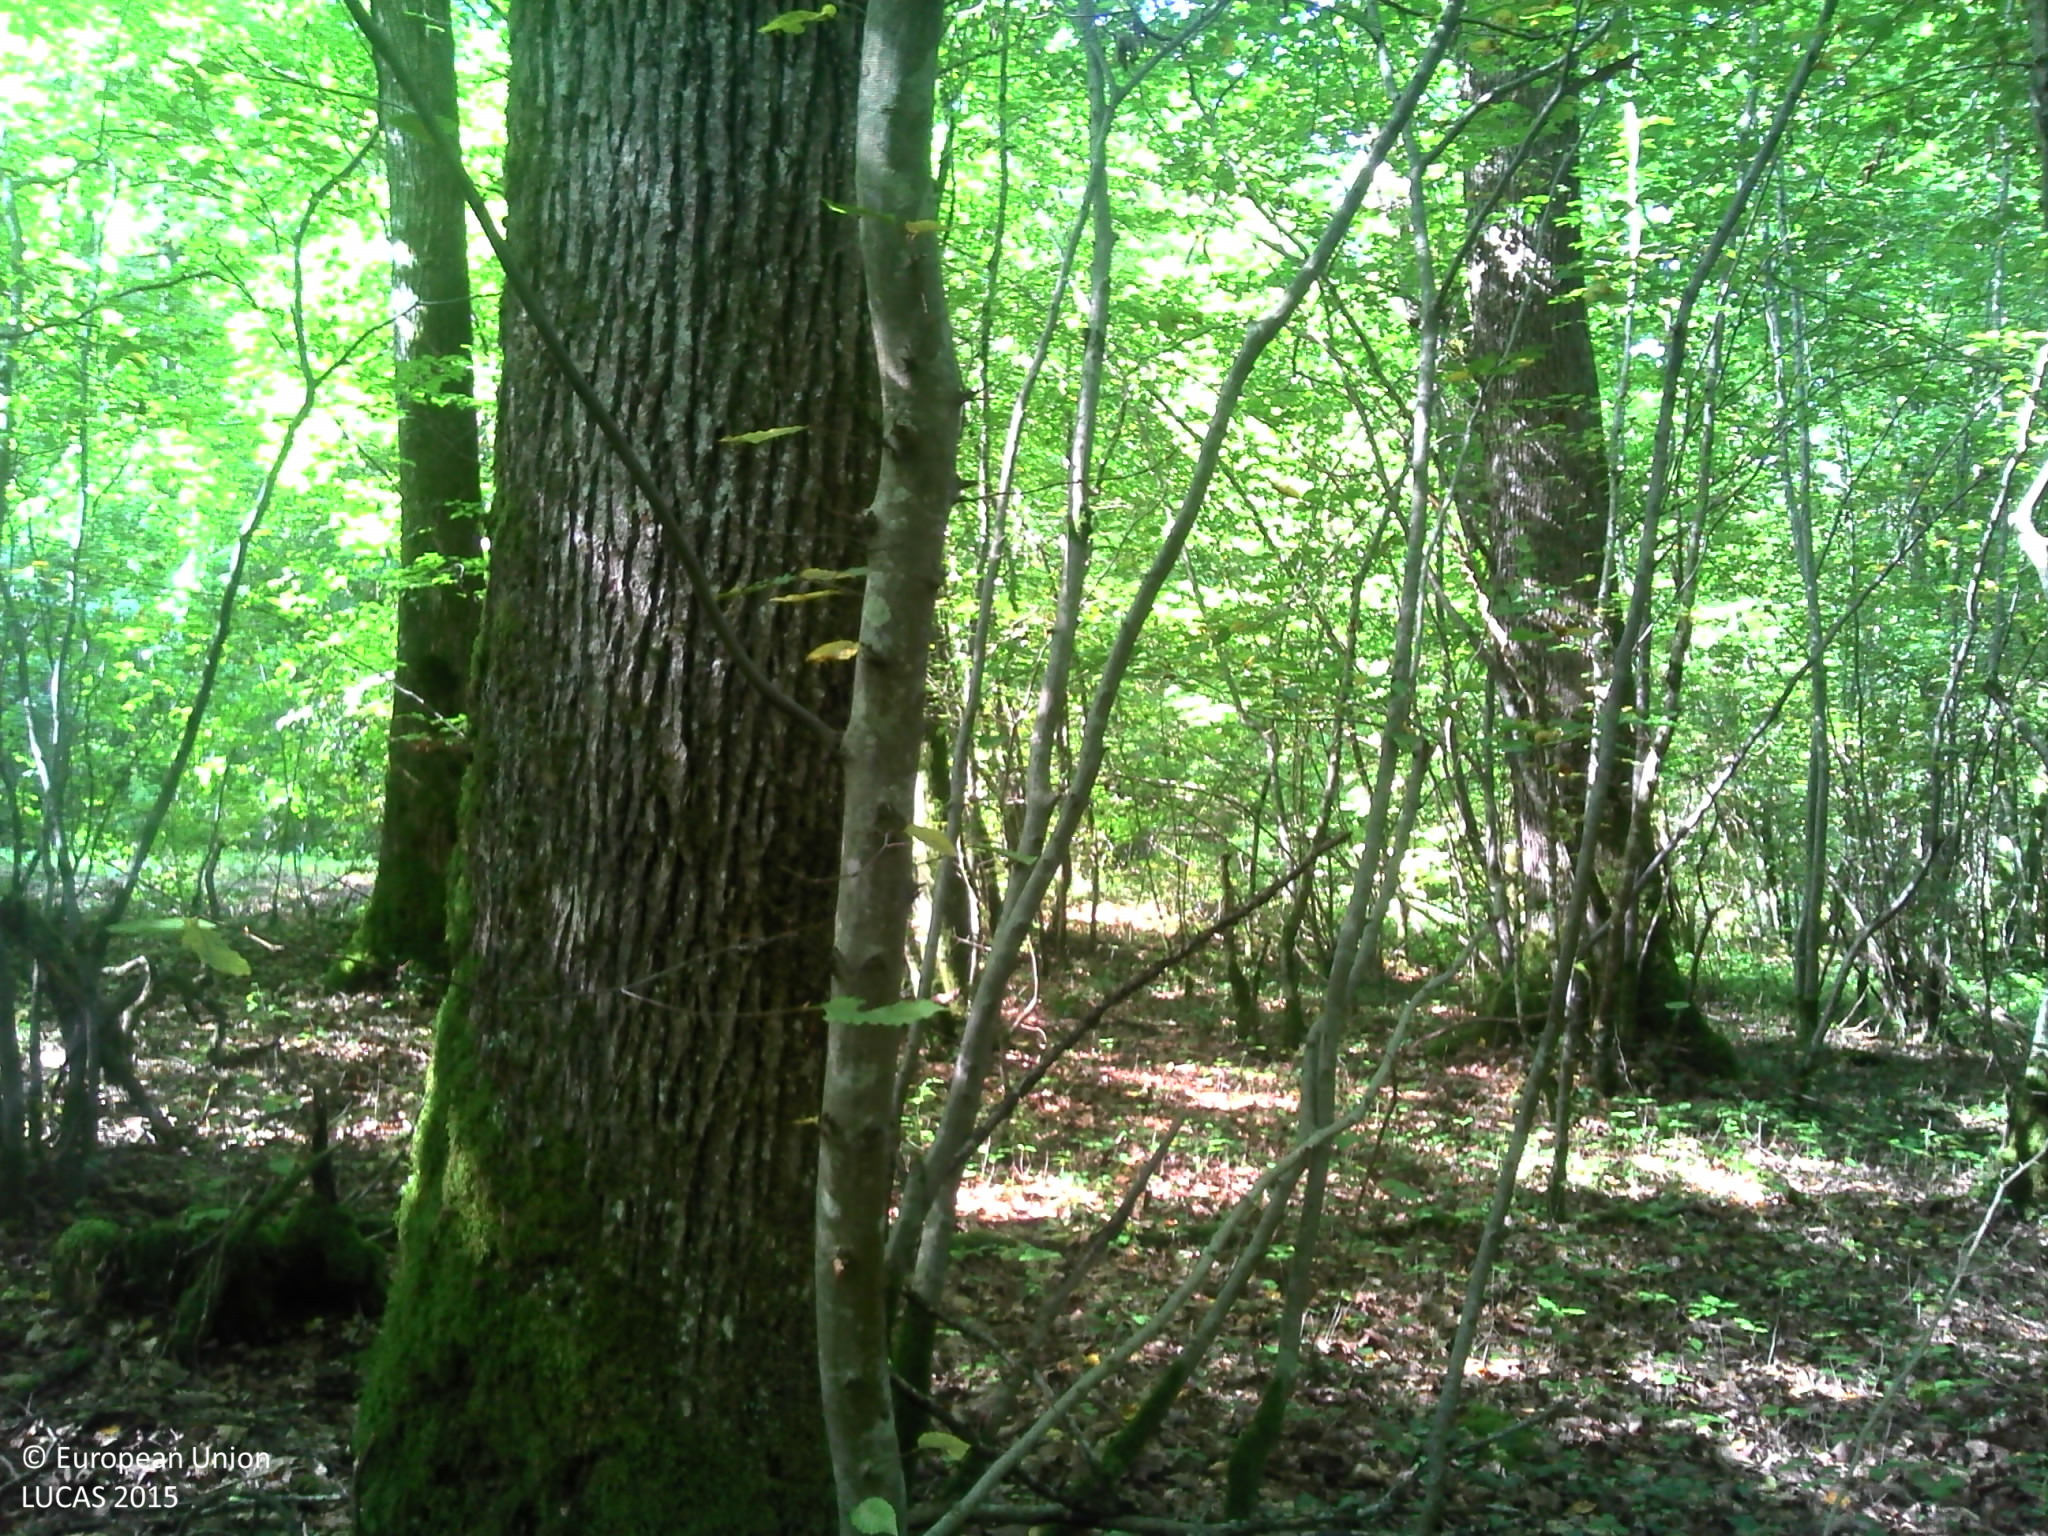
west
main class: Woodland
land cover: Broadleaved woodland
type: mesophytic deciduous forest
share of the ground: > 75 %
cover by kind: broadleaved forest trees 90 %, herbaceous plants 5 %, consolidated bare surface 5 %
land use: Forestry
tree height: > 5 m
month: September
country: FR
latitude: 48.4202
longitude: 6.5008
